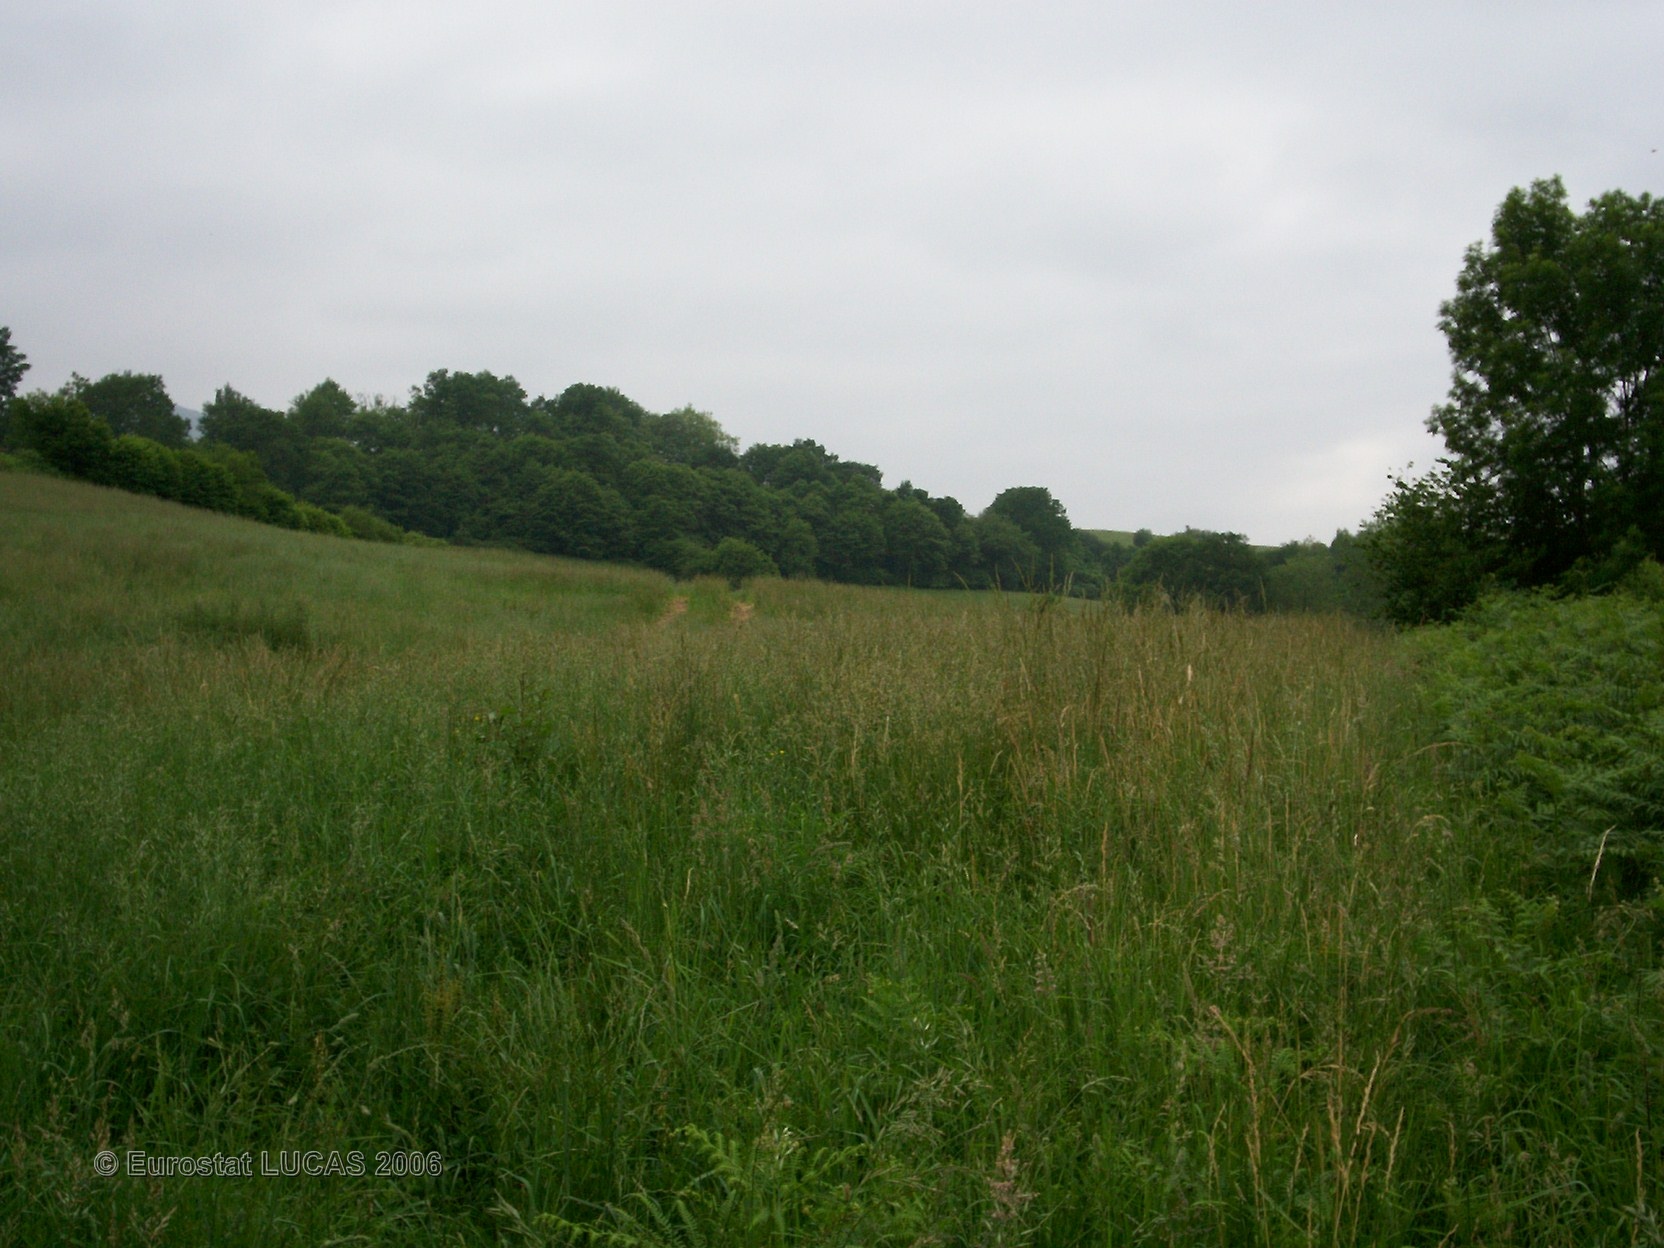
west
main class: Grassland
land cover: Grassland without tree/shrub cover
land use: Agriculture (excluding fallow land and kitchen gardens)
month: May
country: FR
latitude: 43.1677
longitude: -1.2933
